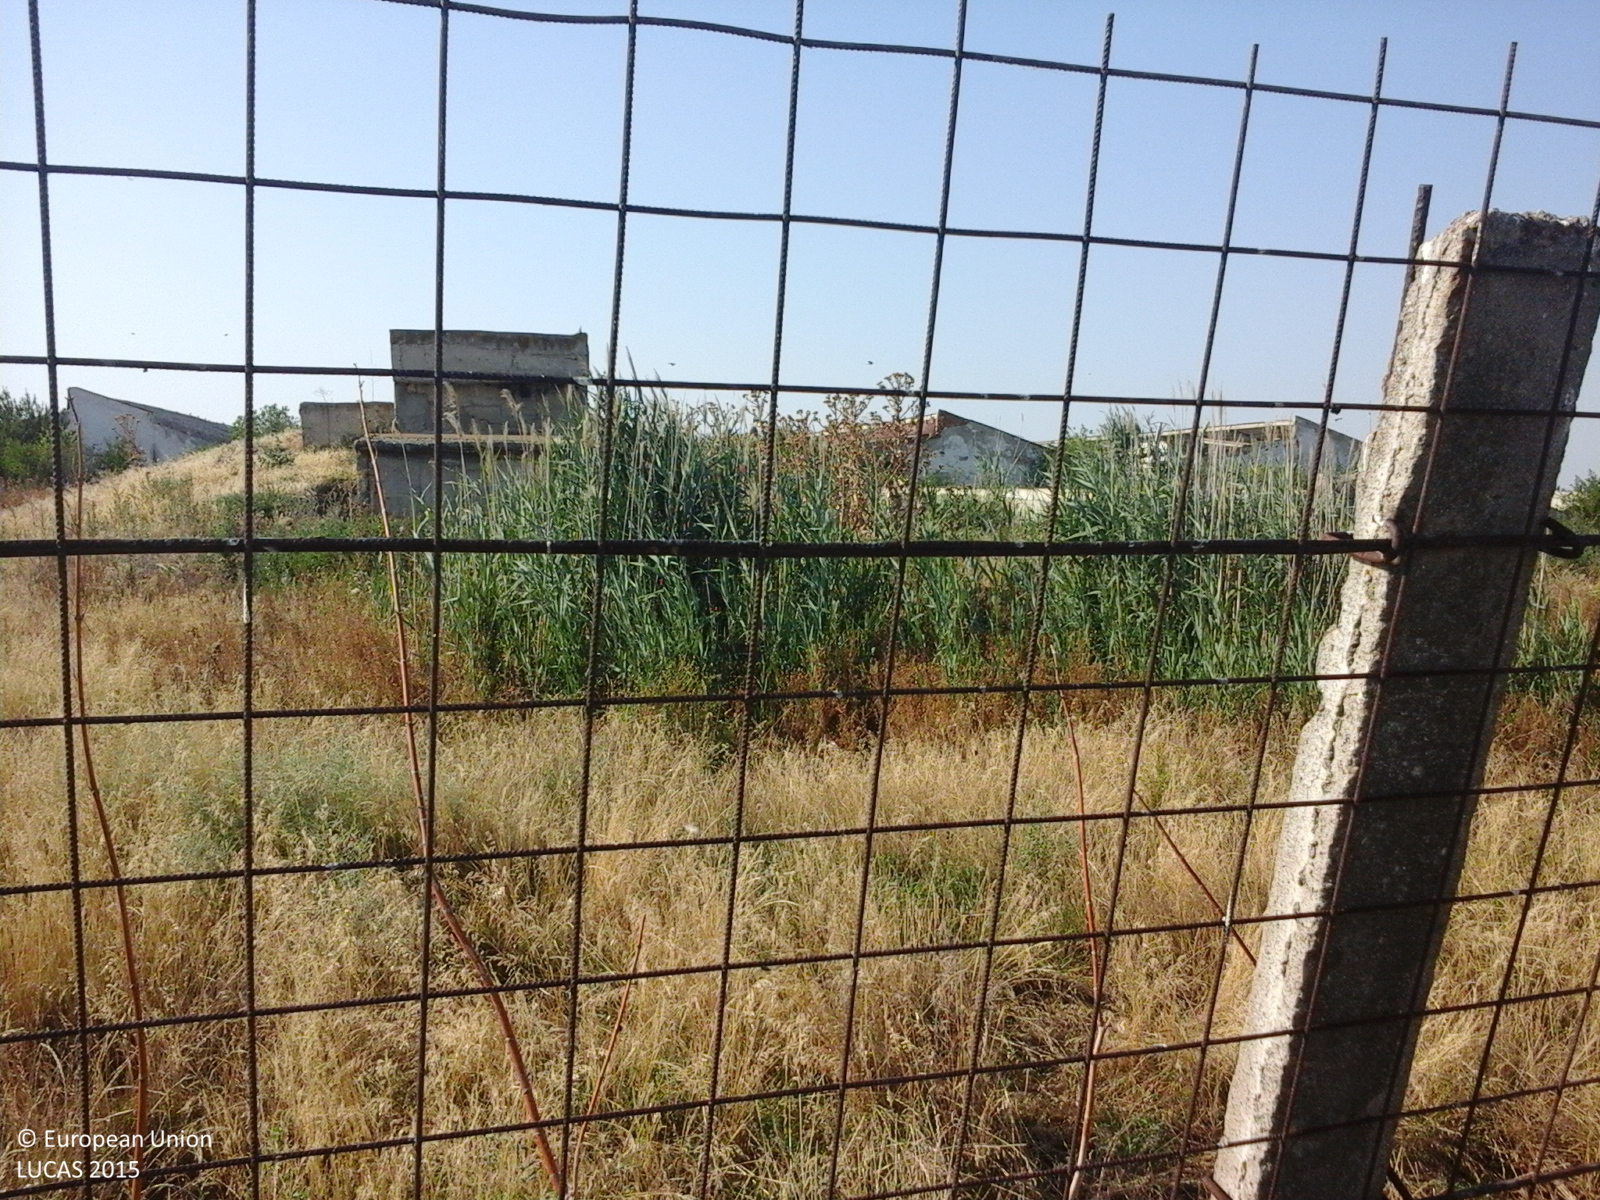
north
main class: Grassland
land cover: Spontaneously vegetated surfaces
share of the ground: > 75 %
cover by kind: herbaceous plants 100 %
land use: Agriculture (excluding fallow land and kitchen gardens)
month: July
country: RO
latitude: 44.9702
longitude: 27.3756
